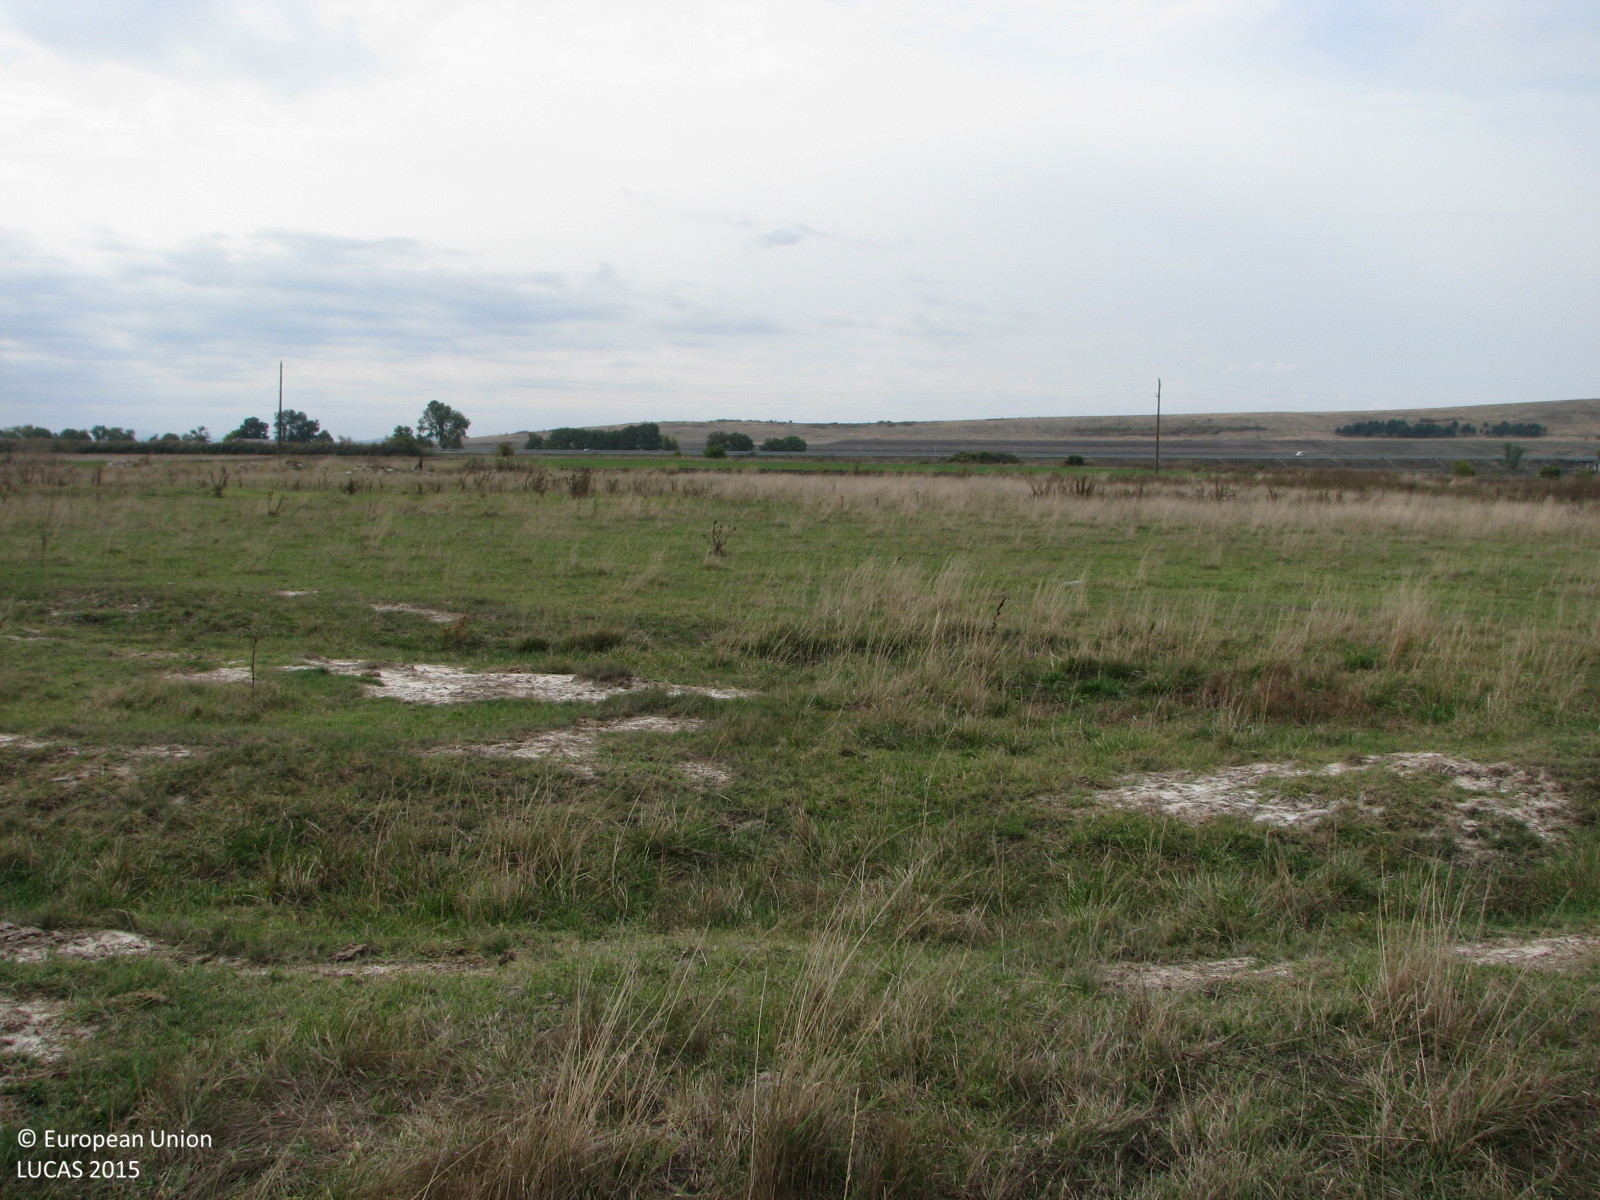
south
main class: Grassland
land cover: Grassland without tree/shrub cover
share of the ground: > 75 %
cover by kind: herbaceous plants 95 %, unconsolidated bare surface 5 %
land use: Agriculture (excluding fallow land and kitchen gardens)
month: October
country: BG
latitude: 42.5024
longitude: 26.2842
